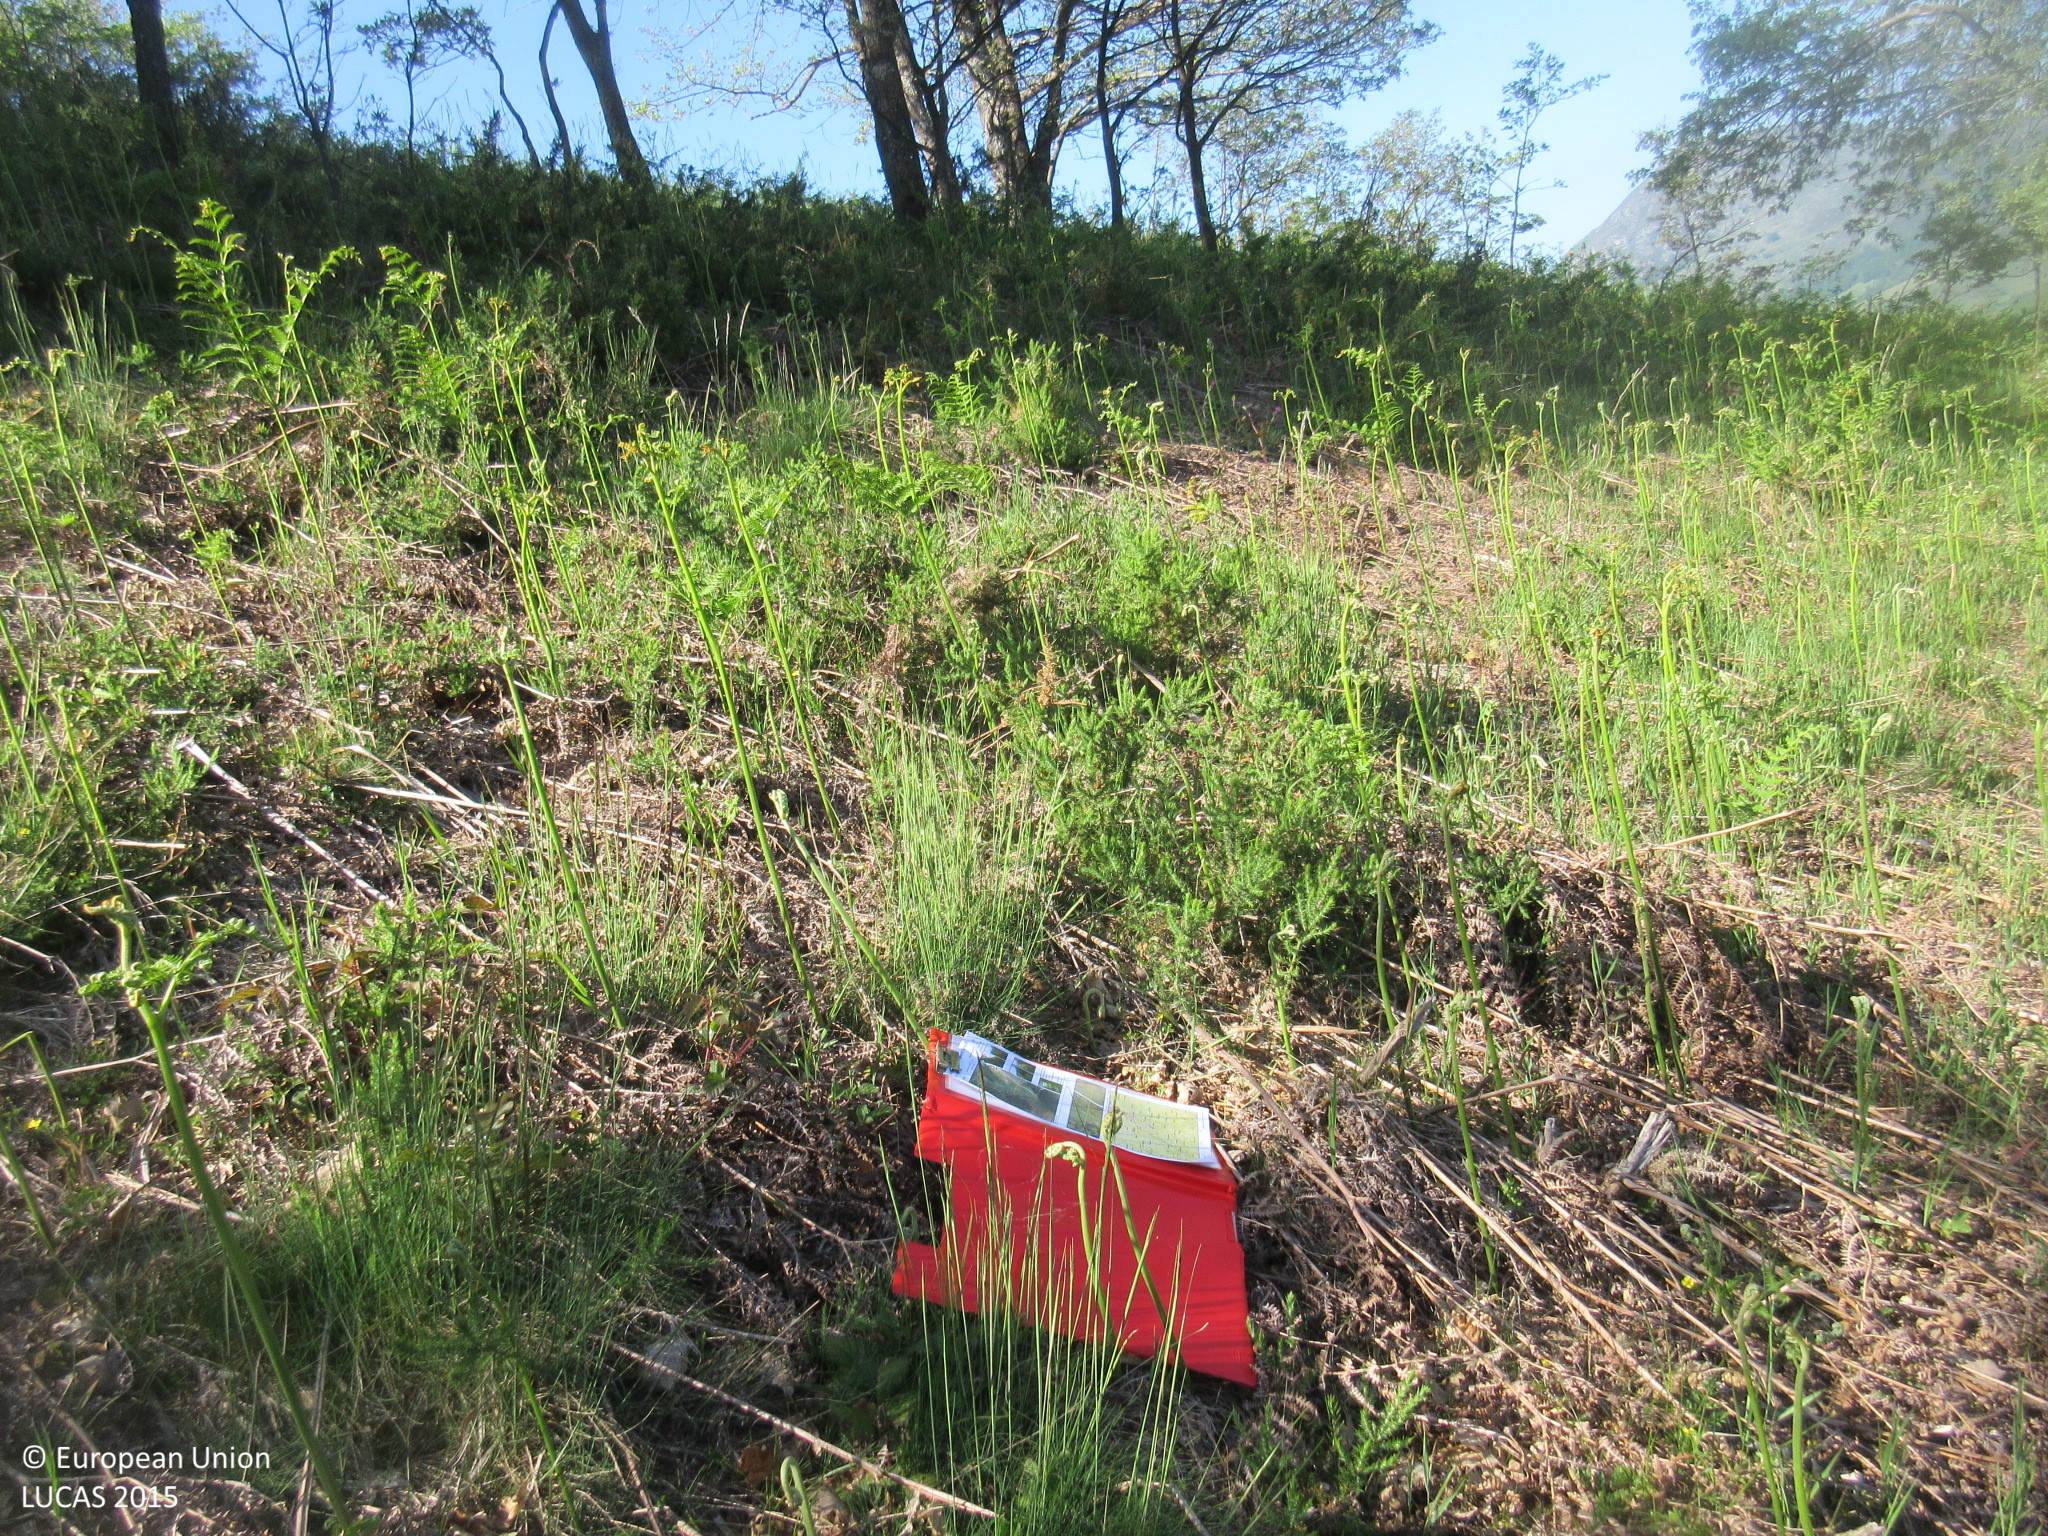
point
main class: Woodland
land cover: Broadleaved woodland
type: acidophilous oak and oak-birch forest
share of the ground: 50 - 75 %
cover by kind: broadleaved forest trees 60 %, shrubs 30 %, herbaceous plants 10 %
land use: Agriculture (excluding fallow land and kitchen gardens)
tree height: > 5 m
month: June
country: ES
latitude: 43.0994
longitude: -4.4190
